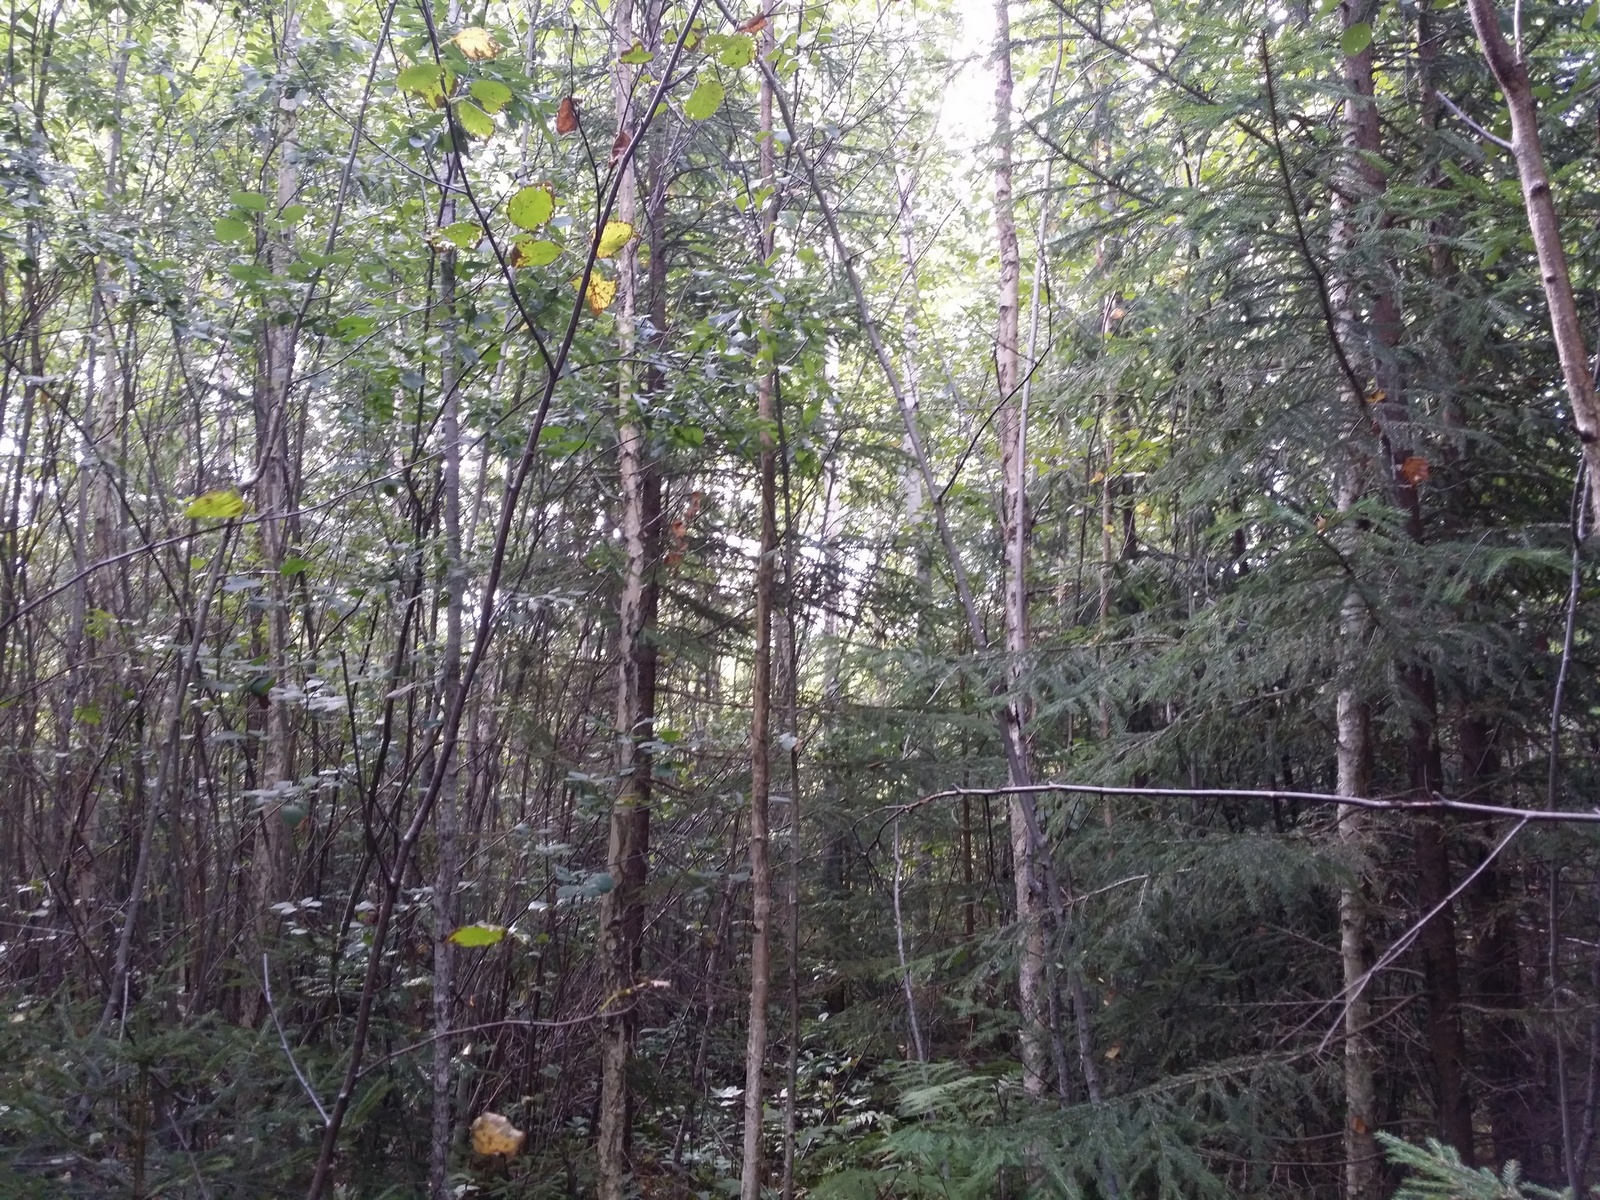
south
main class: Woodland
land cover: Spruce dominated mixed woodland
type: hemiboreal forest and nemoral coniferous forest and mixed broadleaved-coniferous forest
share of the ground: > 75 %
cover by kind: coniferous forest trees 50 %, broadleaved forest trees 40 %, shrubs 5 %, lichens and mosses 5 %
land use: Forestry
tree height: > 5 m
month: August
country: LV
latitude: 57.3292
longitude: 27.6707
